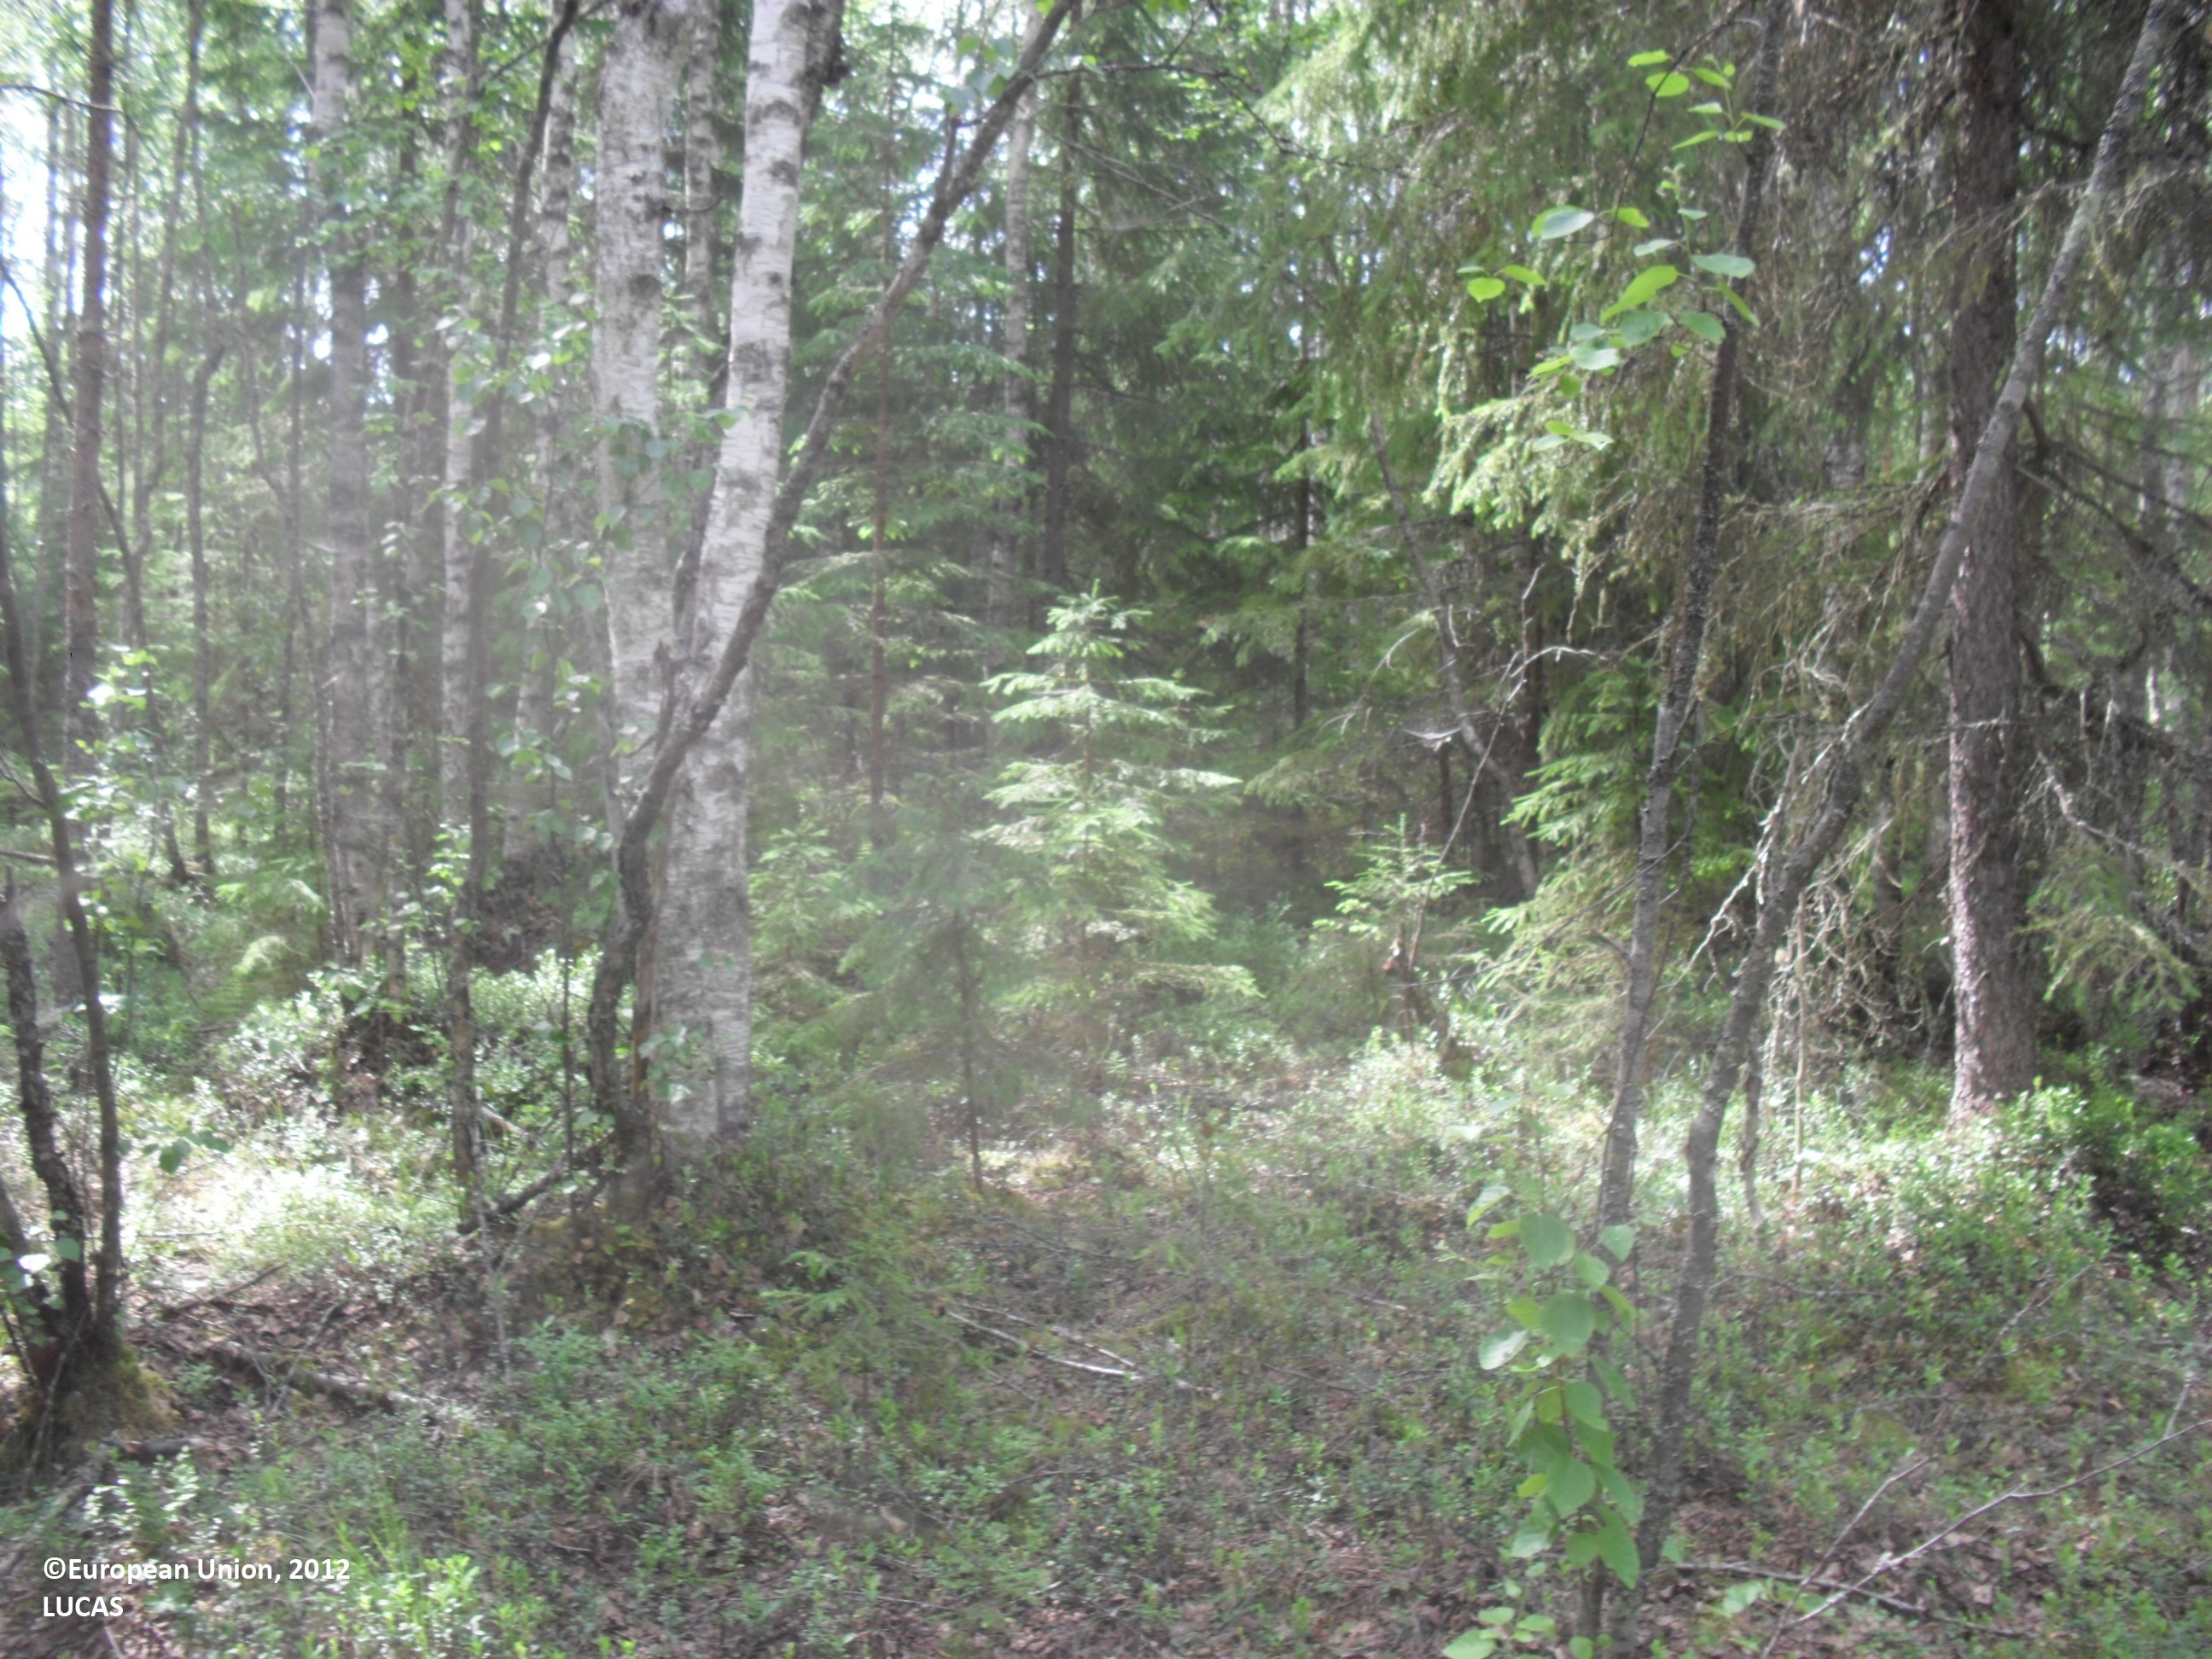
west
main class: Woodland
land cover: Other mixed woodland
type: boreal forest
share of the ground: 50 - 75 %
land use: Forestry
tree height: > 5 m
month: July
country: FI
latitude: 63.5513
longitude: 24.0162
